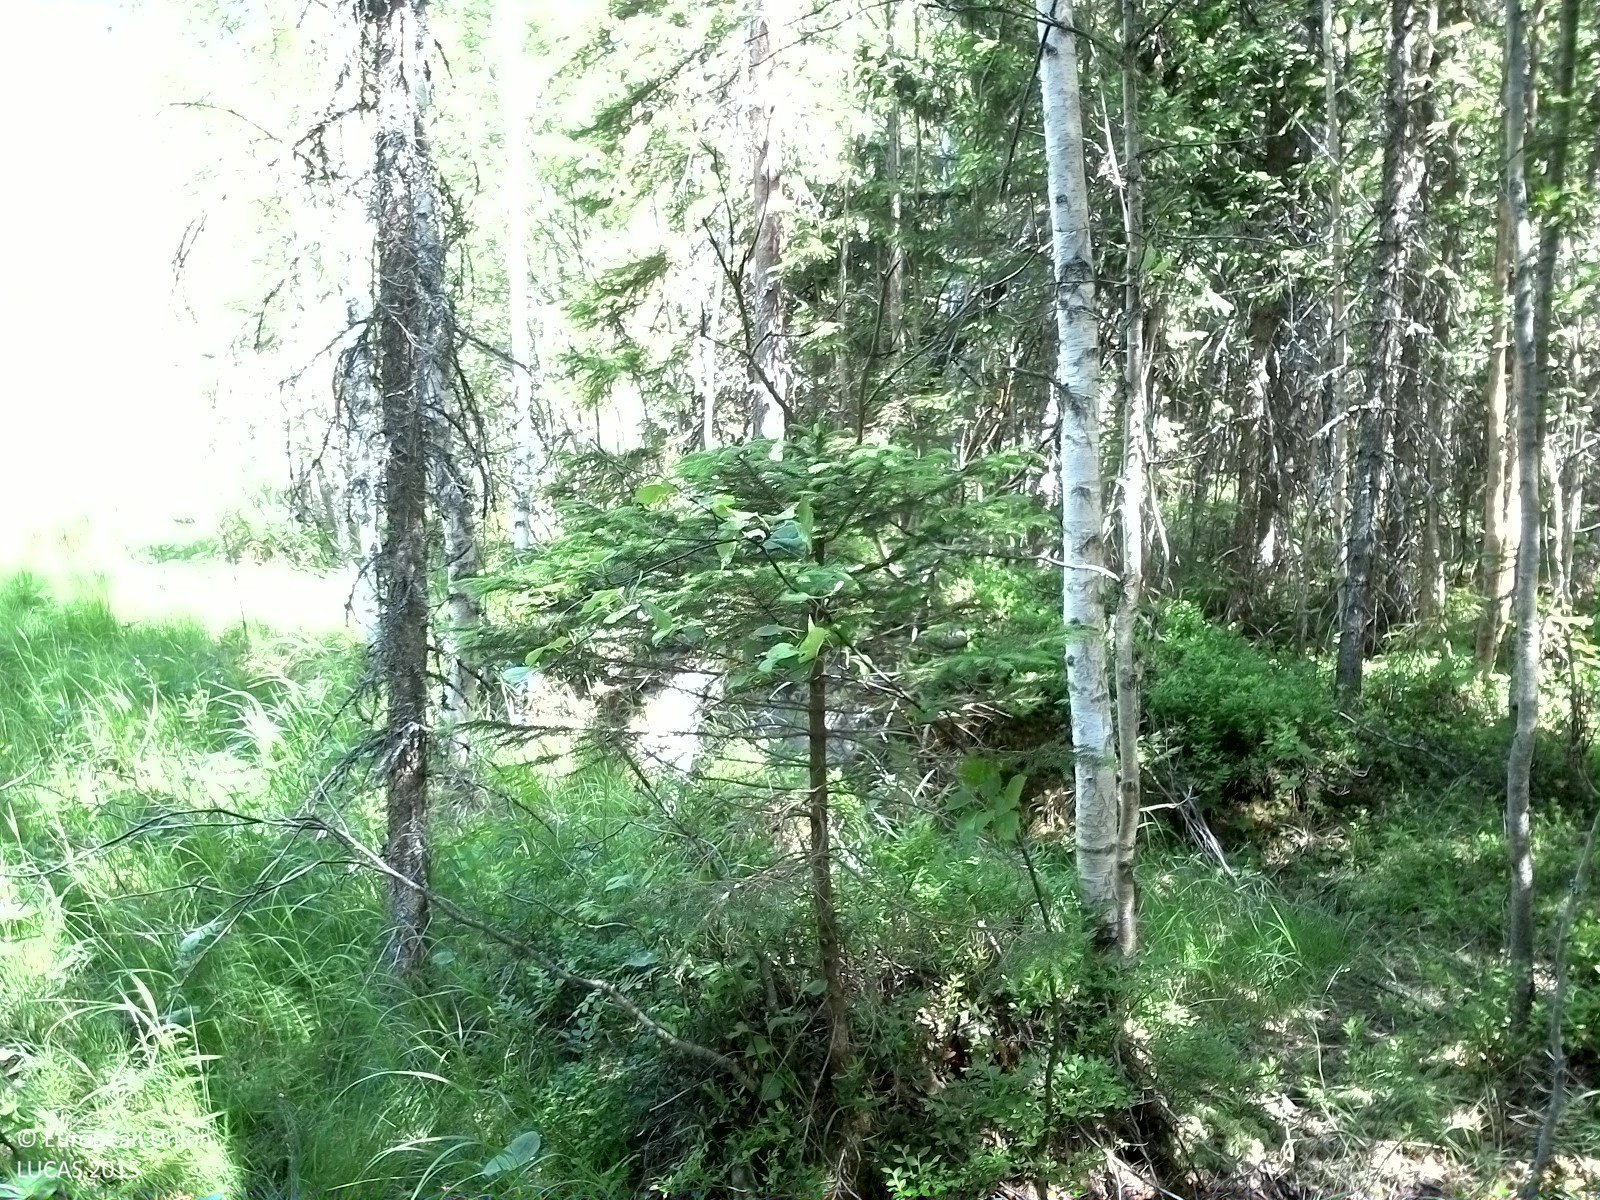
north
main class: Woodland
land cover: Spruce dominated mixed woodland
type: boreal forest
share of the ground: 50 - 75 %
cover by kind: coniferous forest trees 45 %, shrubs 30 %, broadleaved forest trees 15 %, herbaceous plants 10 %
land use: Forestry
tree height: > 5 m
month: July
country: SE
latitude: 62.2535
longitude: 16.9314
